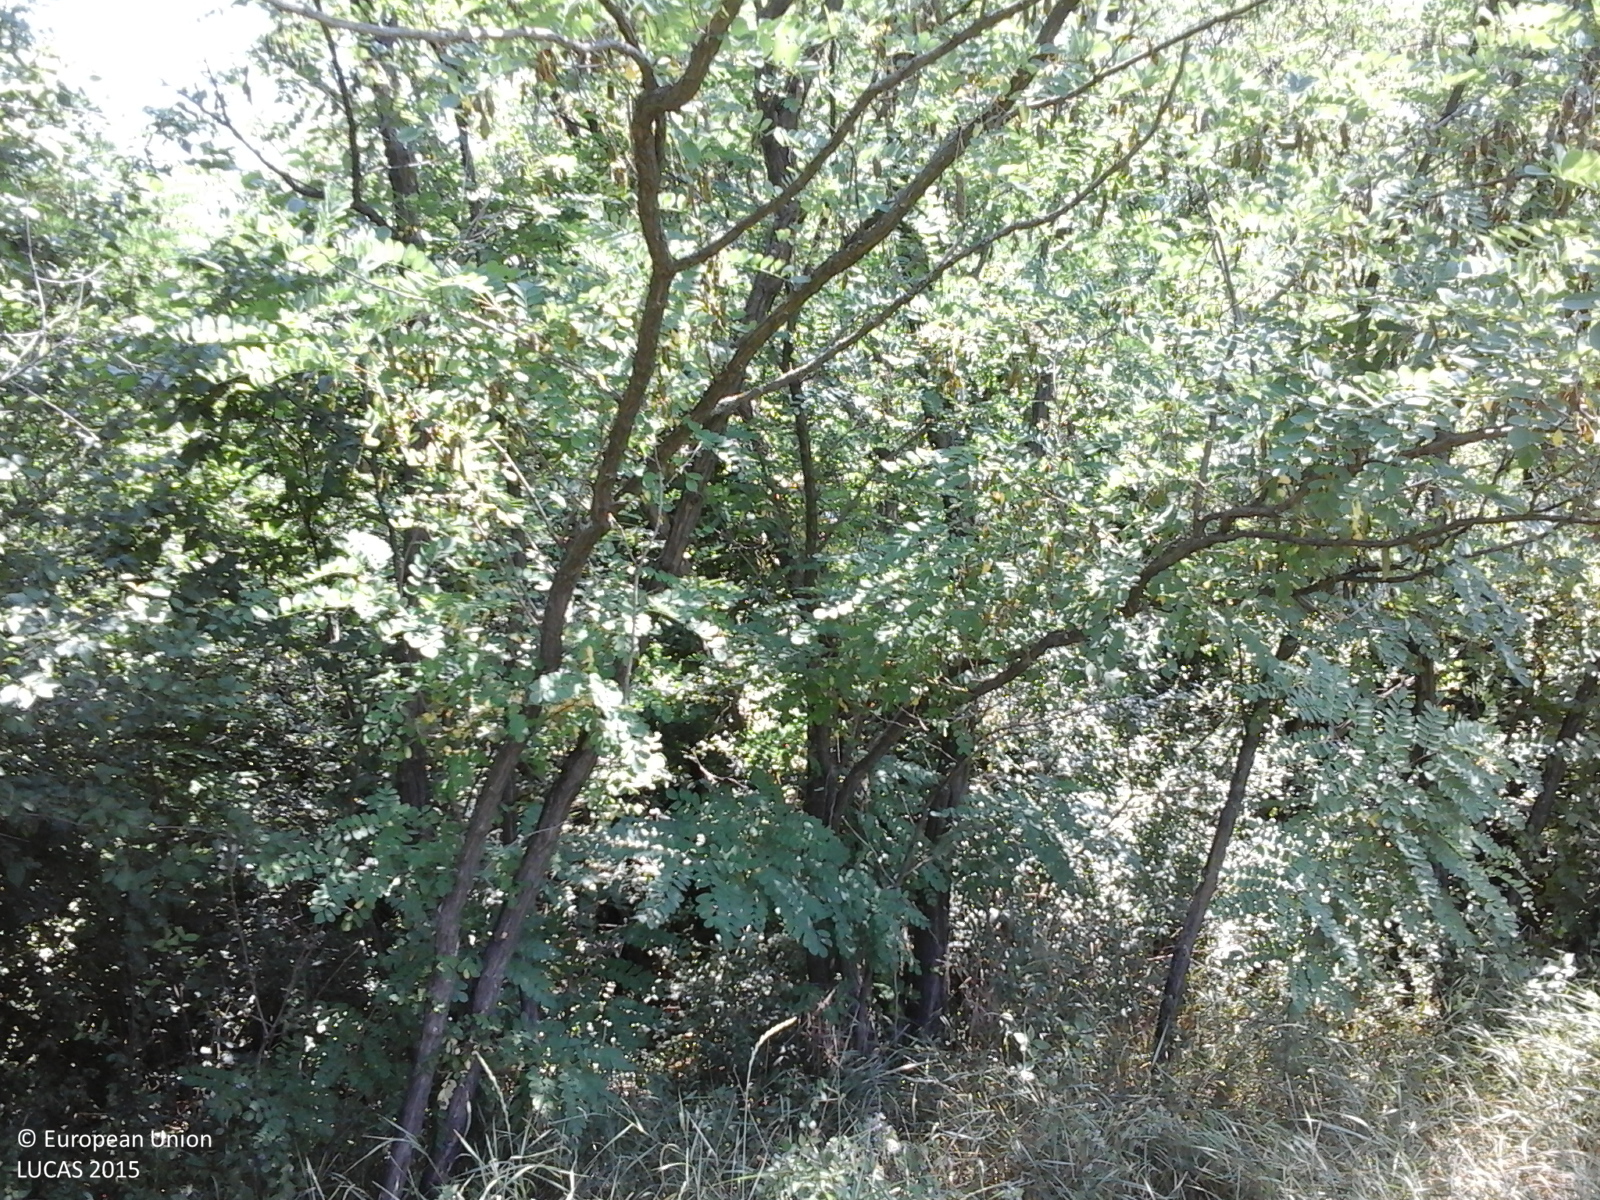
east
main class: Woodland
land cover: Broadleaved woodland
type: thermophilous deciduous forest
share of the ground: > 75 %
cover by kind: broadleaved forest trees 85 %, herbaceous plants 10 %, shrubs 5 %
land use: Forestry
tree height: > 5 m
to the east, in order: Broadleaved woodland; Electric lines; Broadleaved woodland; Grassland with sparse tree/shrub cover; Common wheat
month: July
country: RO
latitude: 44.6881
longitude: 24.5718
